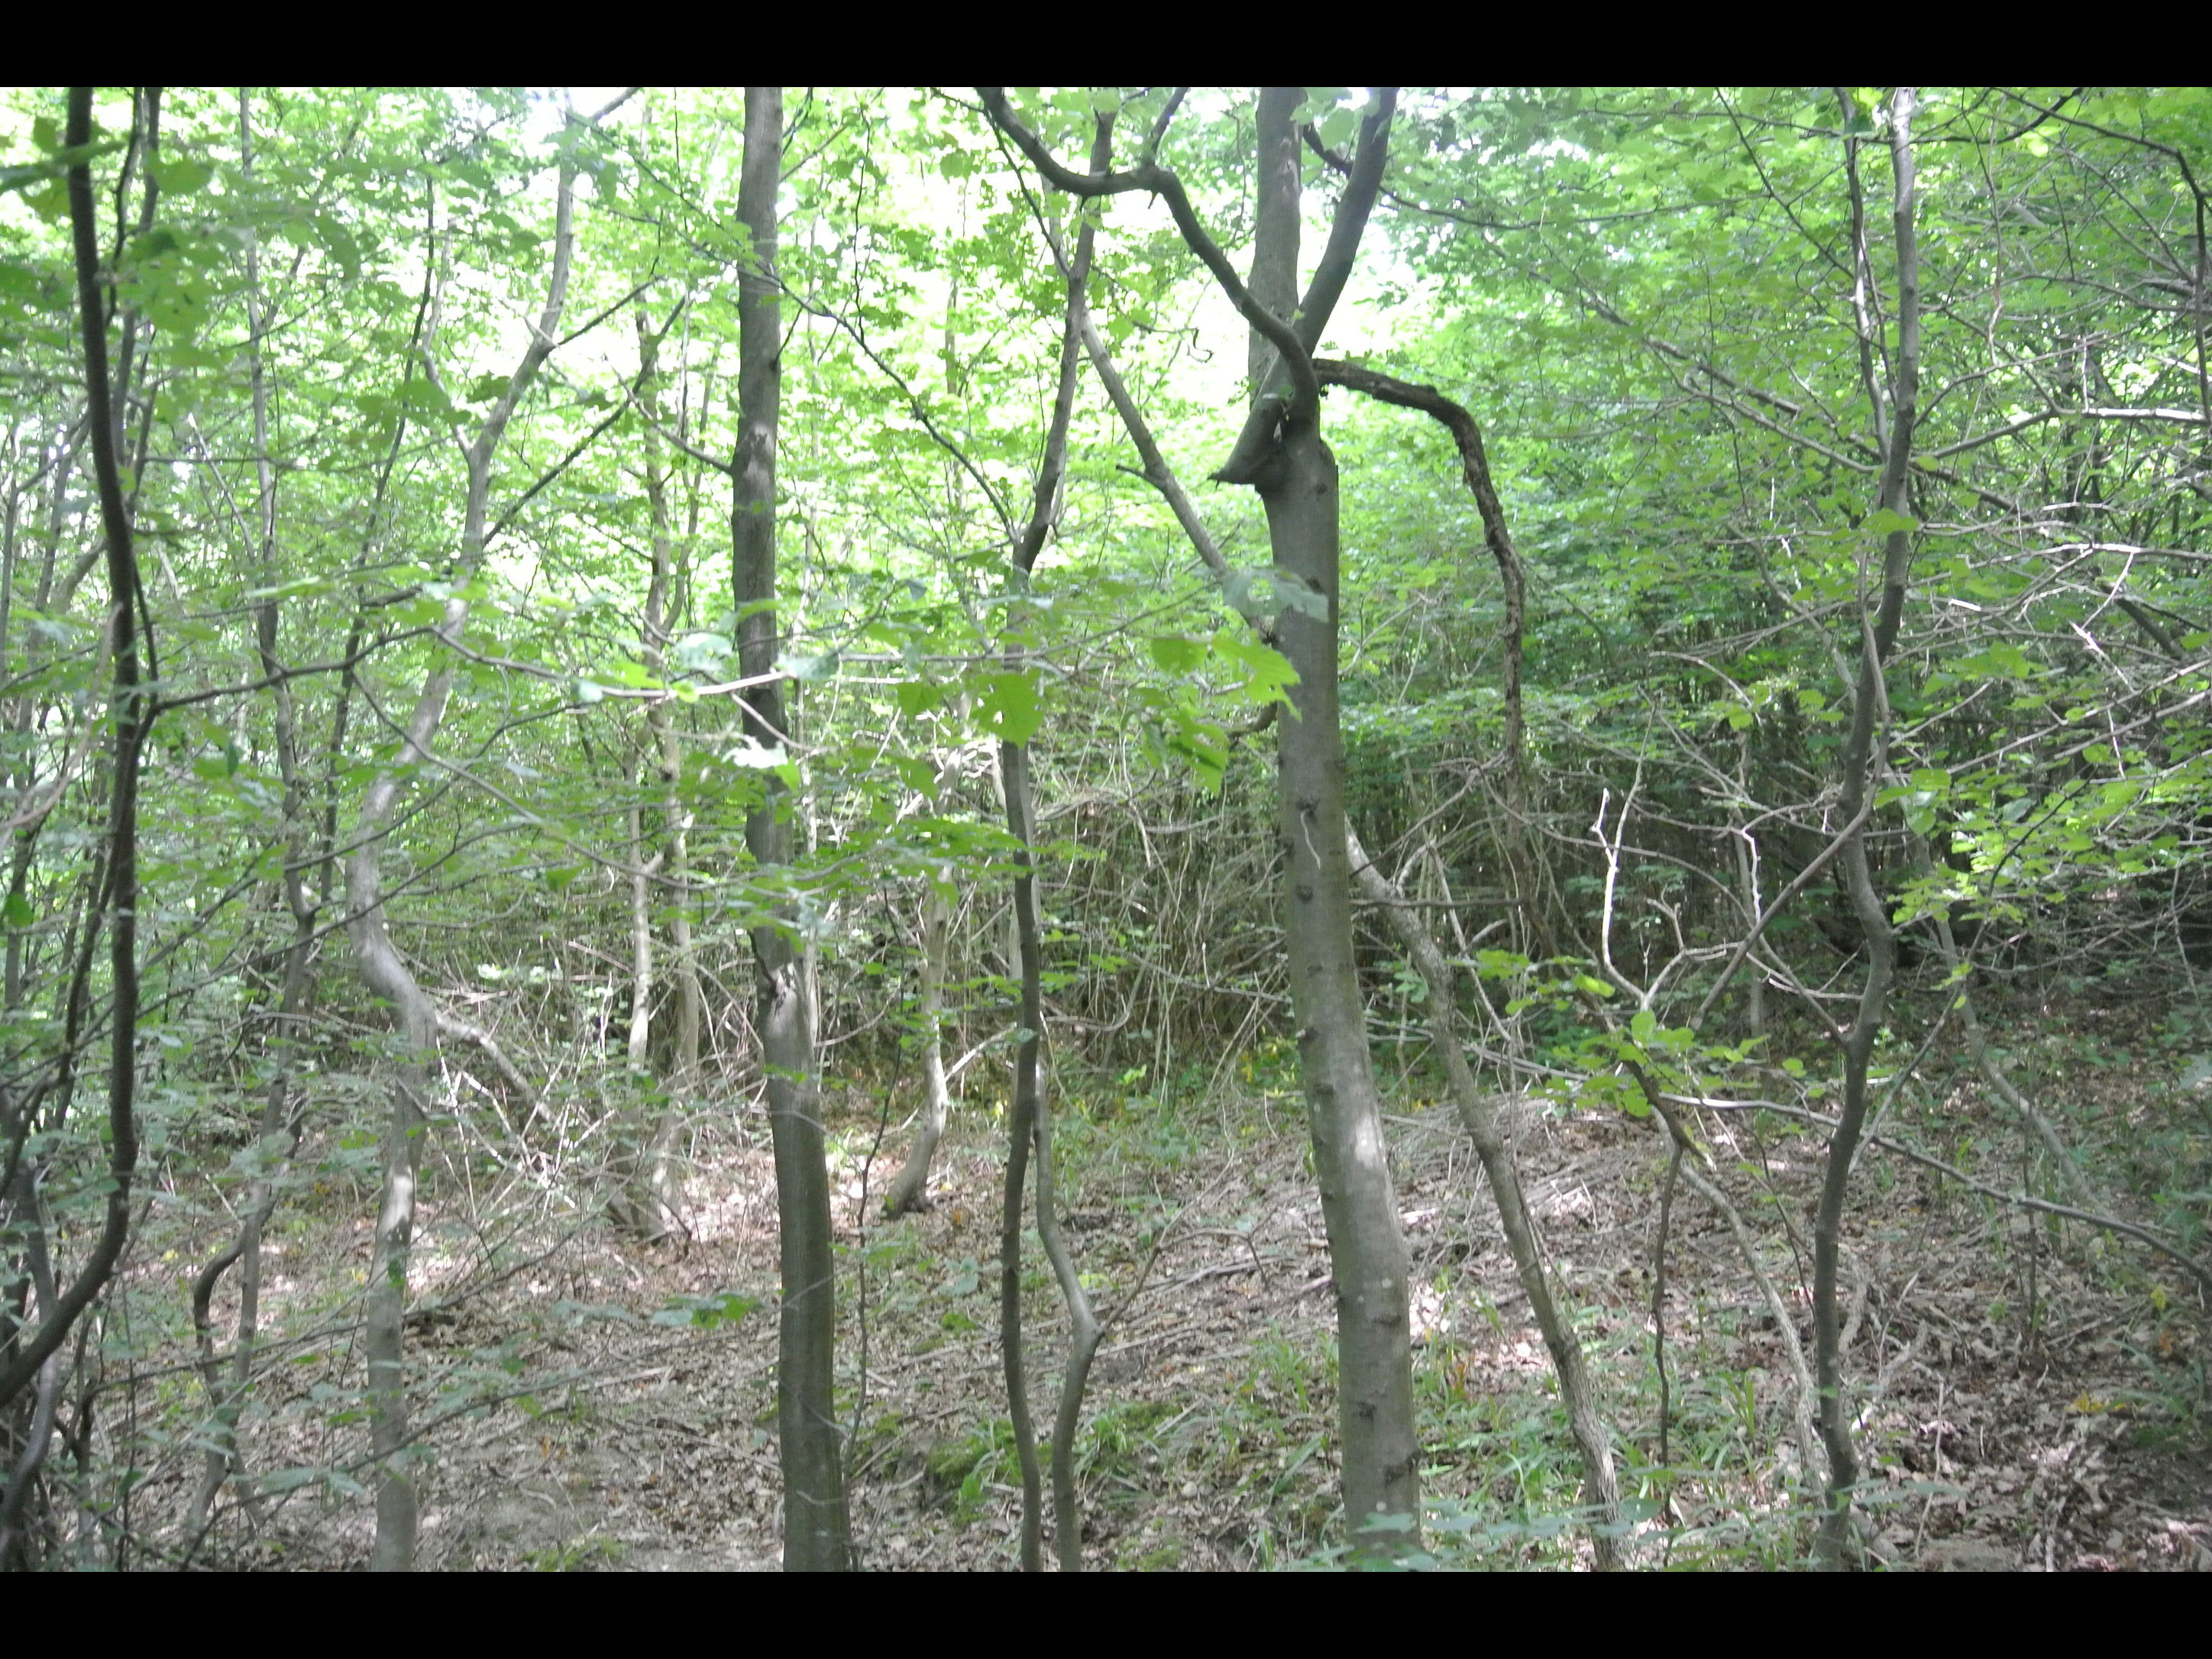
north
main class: Woodland
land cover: Broadleaved woodland
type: beech forest
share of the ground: > 75 %
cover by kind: broadleaved forest trees 90 %, consolidated bare surface 5 %, unconsolidated bare surface 5 %
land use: Forestry
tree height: > 5 m
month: June
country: AT
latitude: 47.9156
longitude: 16.6288
